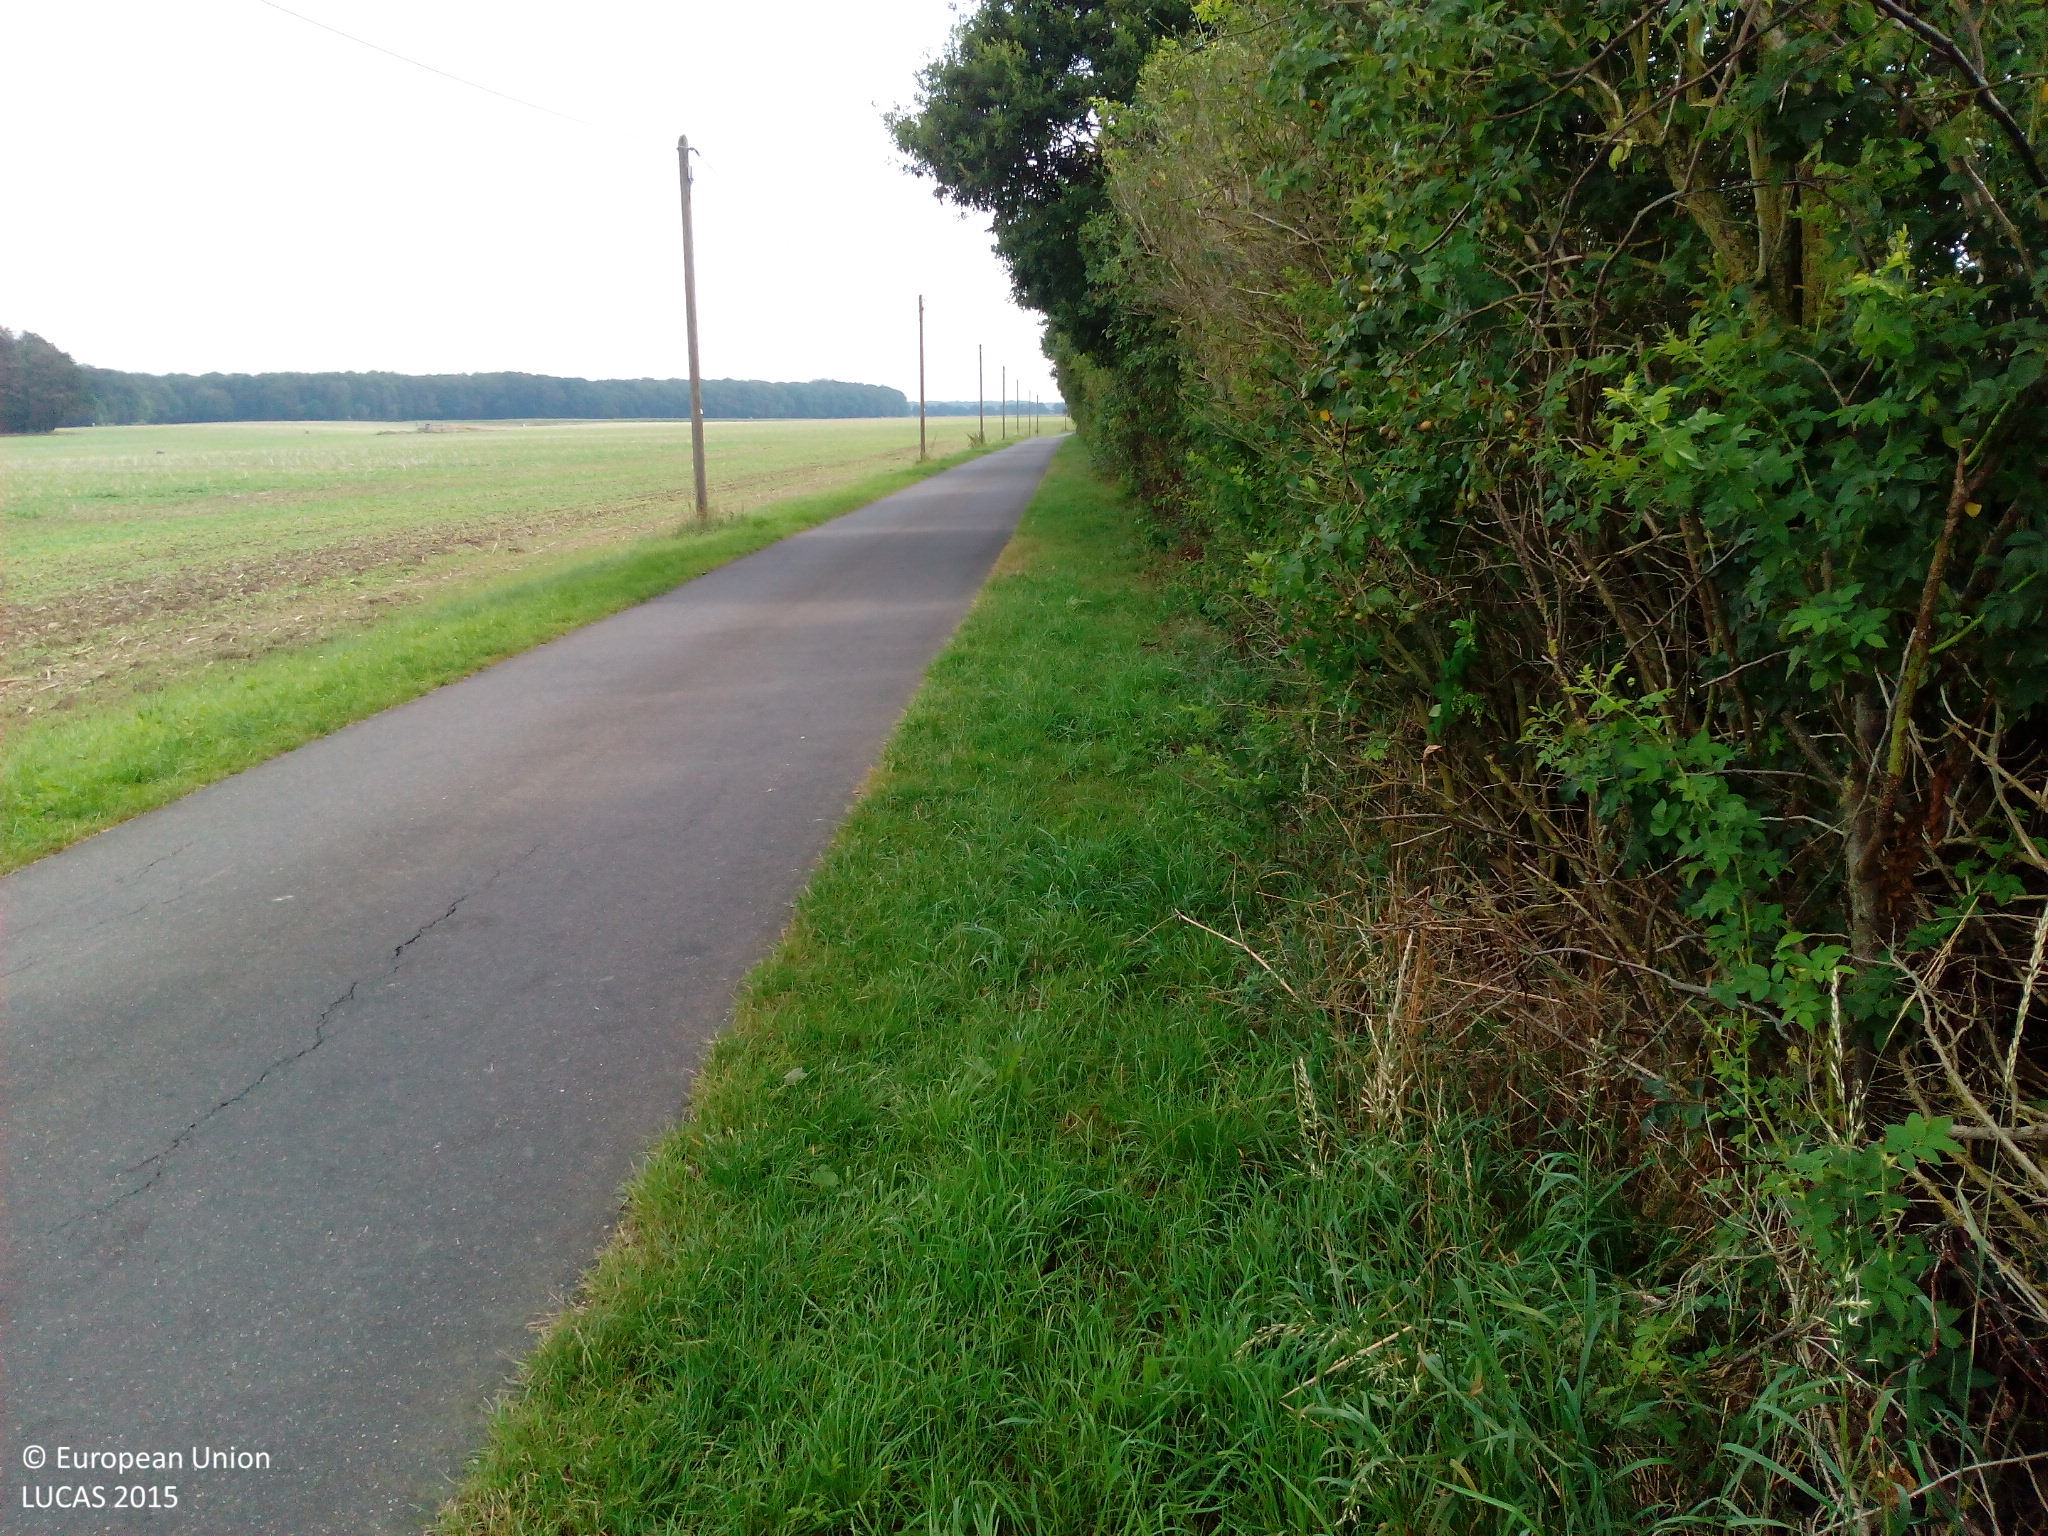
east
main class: Cropland
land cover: Rape and turnip rape
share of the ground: 10 - 25 %
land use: Agriculture (excluding fallow land and kitchen gardens)
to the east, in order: Rape and turnip rape
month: August
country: DE
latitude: 54.2008
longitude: 12.6204
